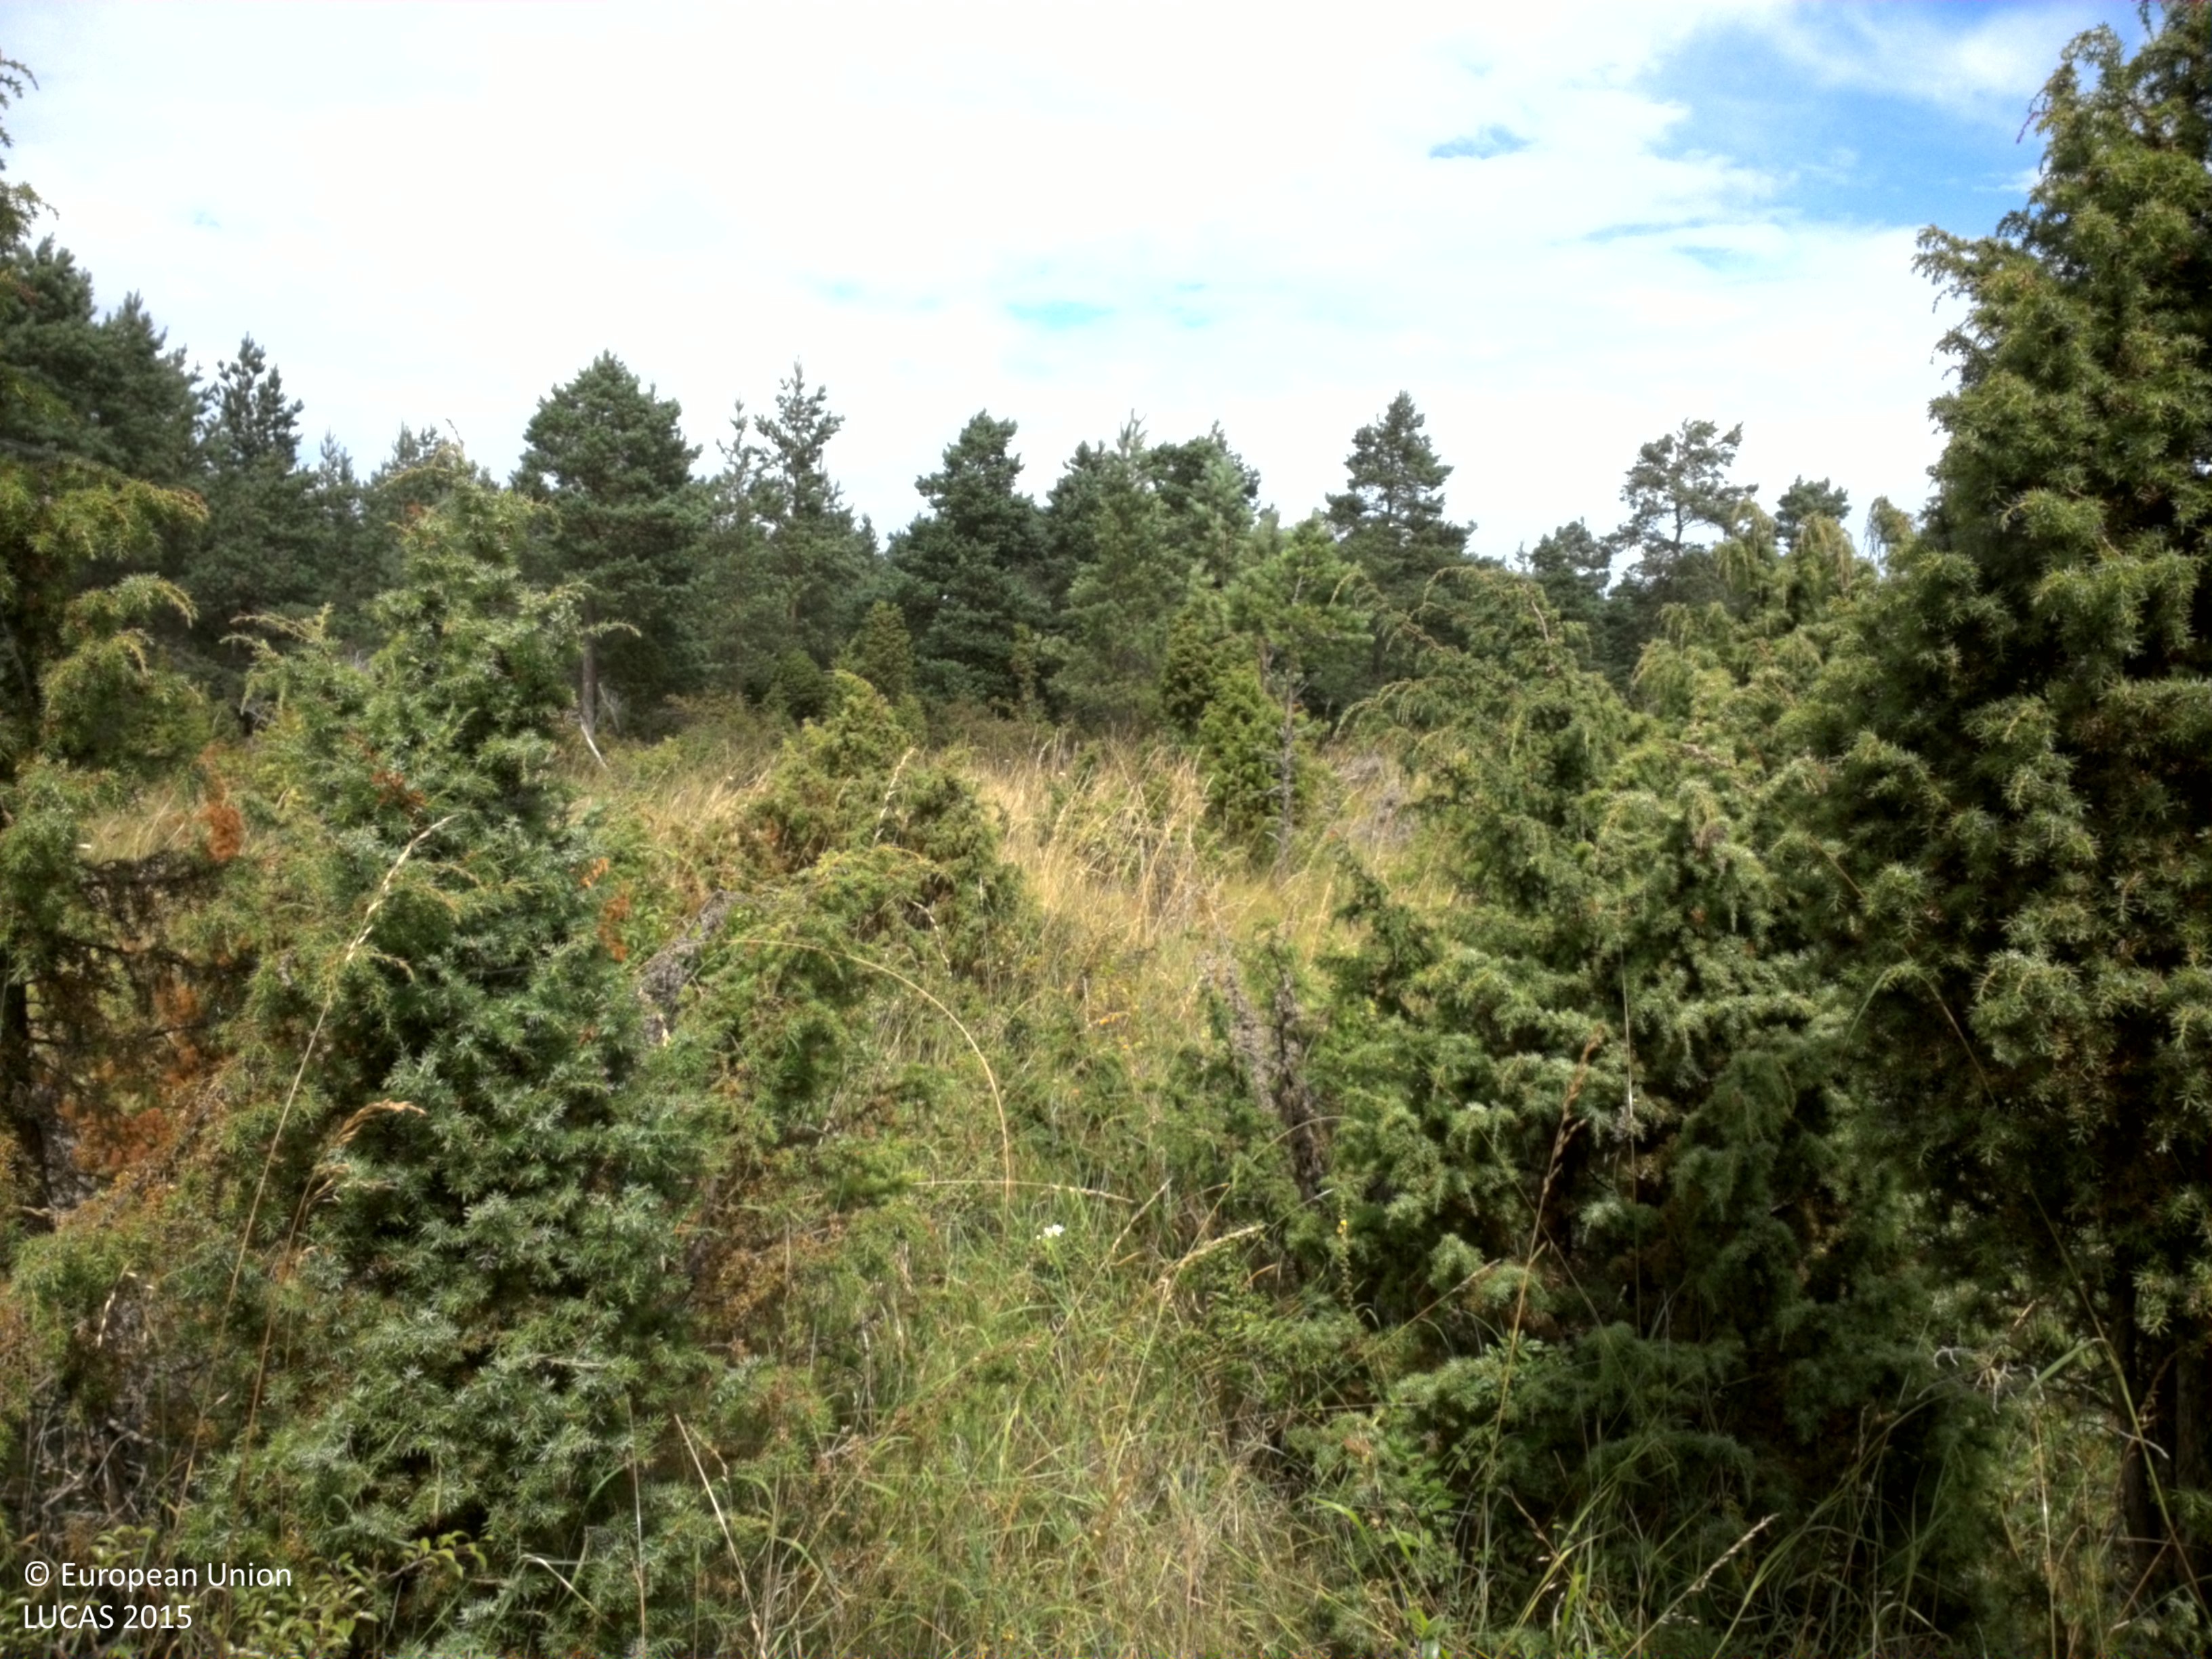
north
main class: Woodland
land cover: Pine dominated coniferous woodland
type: hemiboreal forest and nemoral coniferous forest and mixed broadleaved-coniferous forest
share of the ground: 50 - 75 %
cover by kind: coniferous forest trees 50 %, herbaceous plants 35 %, shrubs 15 %
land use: Forestry
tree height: > 5 m
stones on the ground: < 10 %
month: July
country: SE
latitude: 57.2728
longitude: 18.6175
